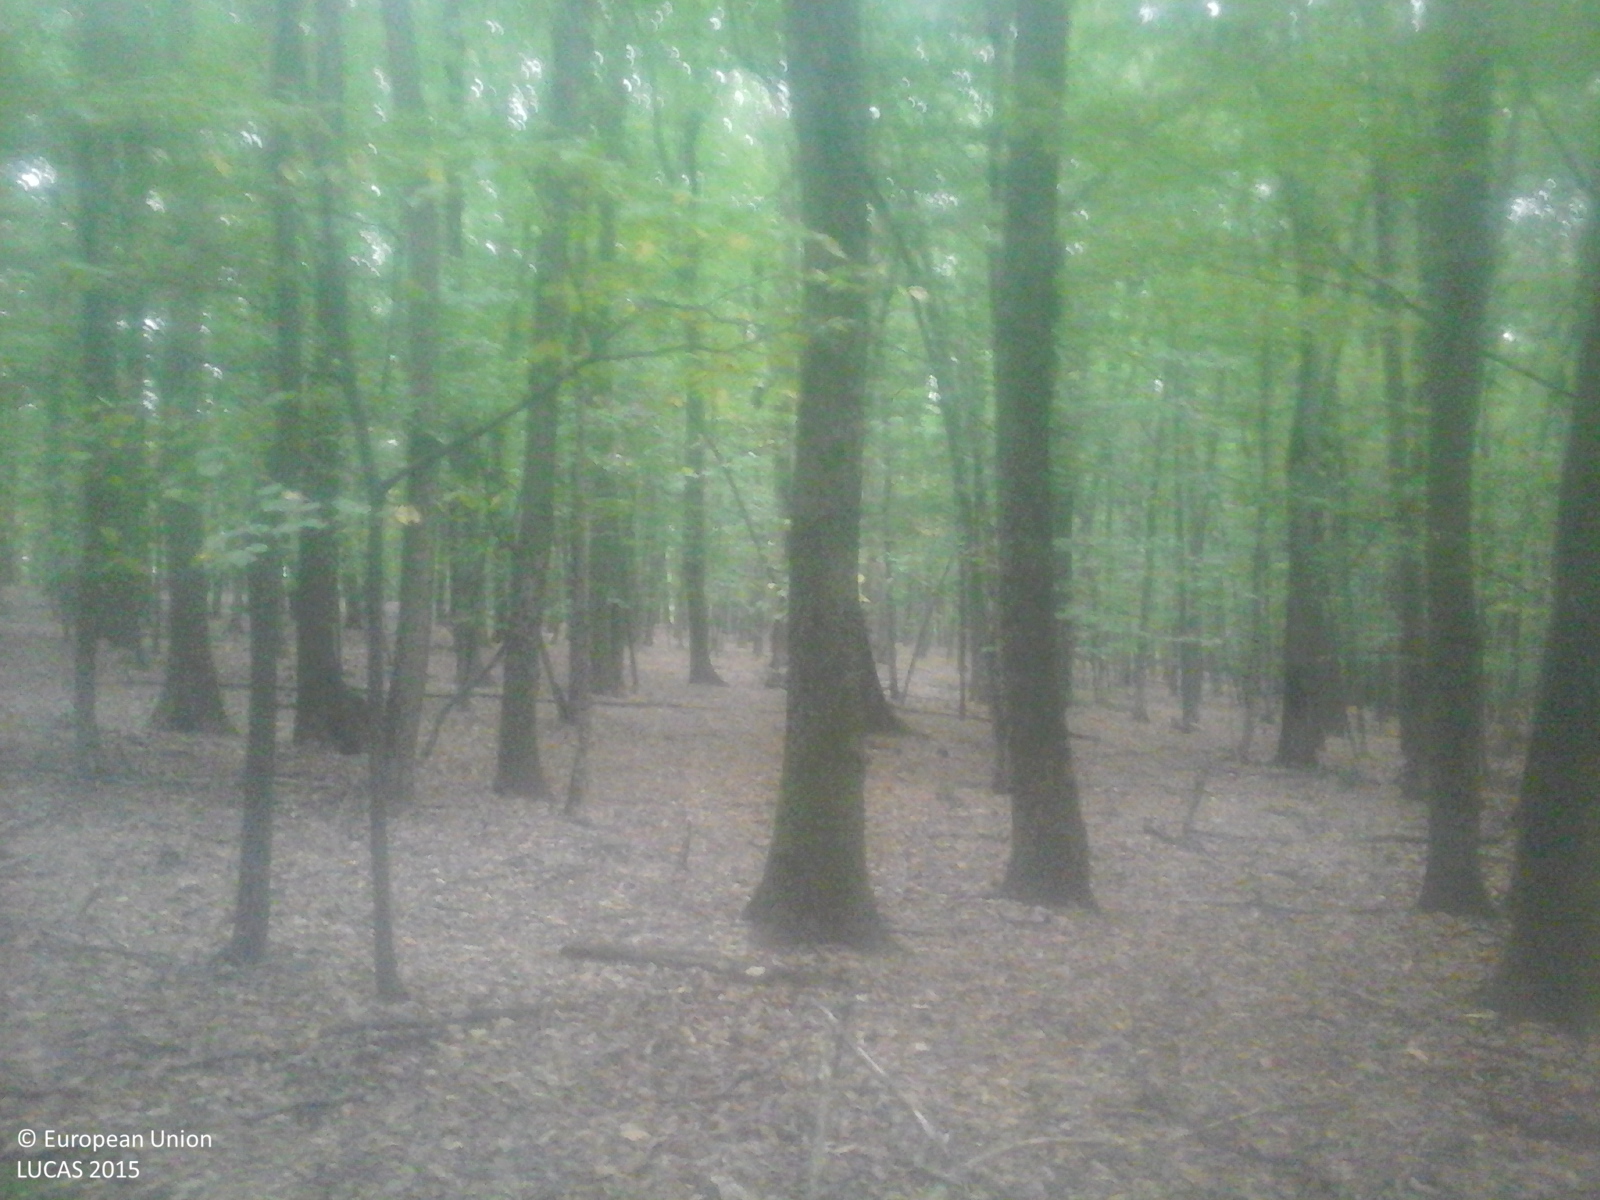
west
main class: Woodland
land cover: Broadleaved woodland
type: beech forest
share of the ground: > 75 %
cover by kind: broadleaved forest trees 100 %
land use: Forestry
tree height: > 5 m
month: September
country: RO
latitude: 45.5113
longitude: 21.9809
